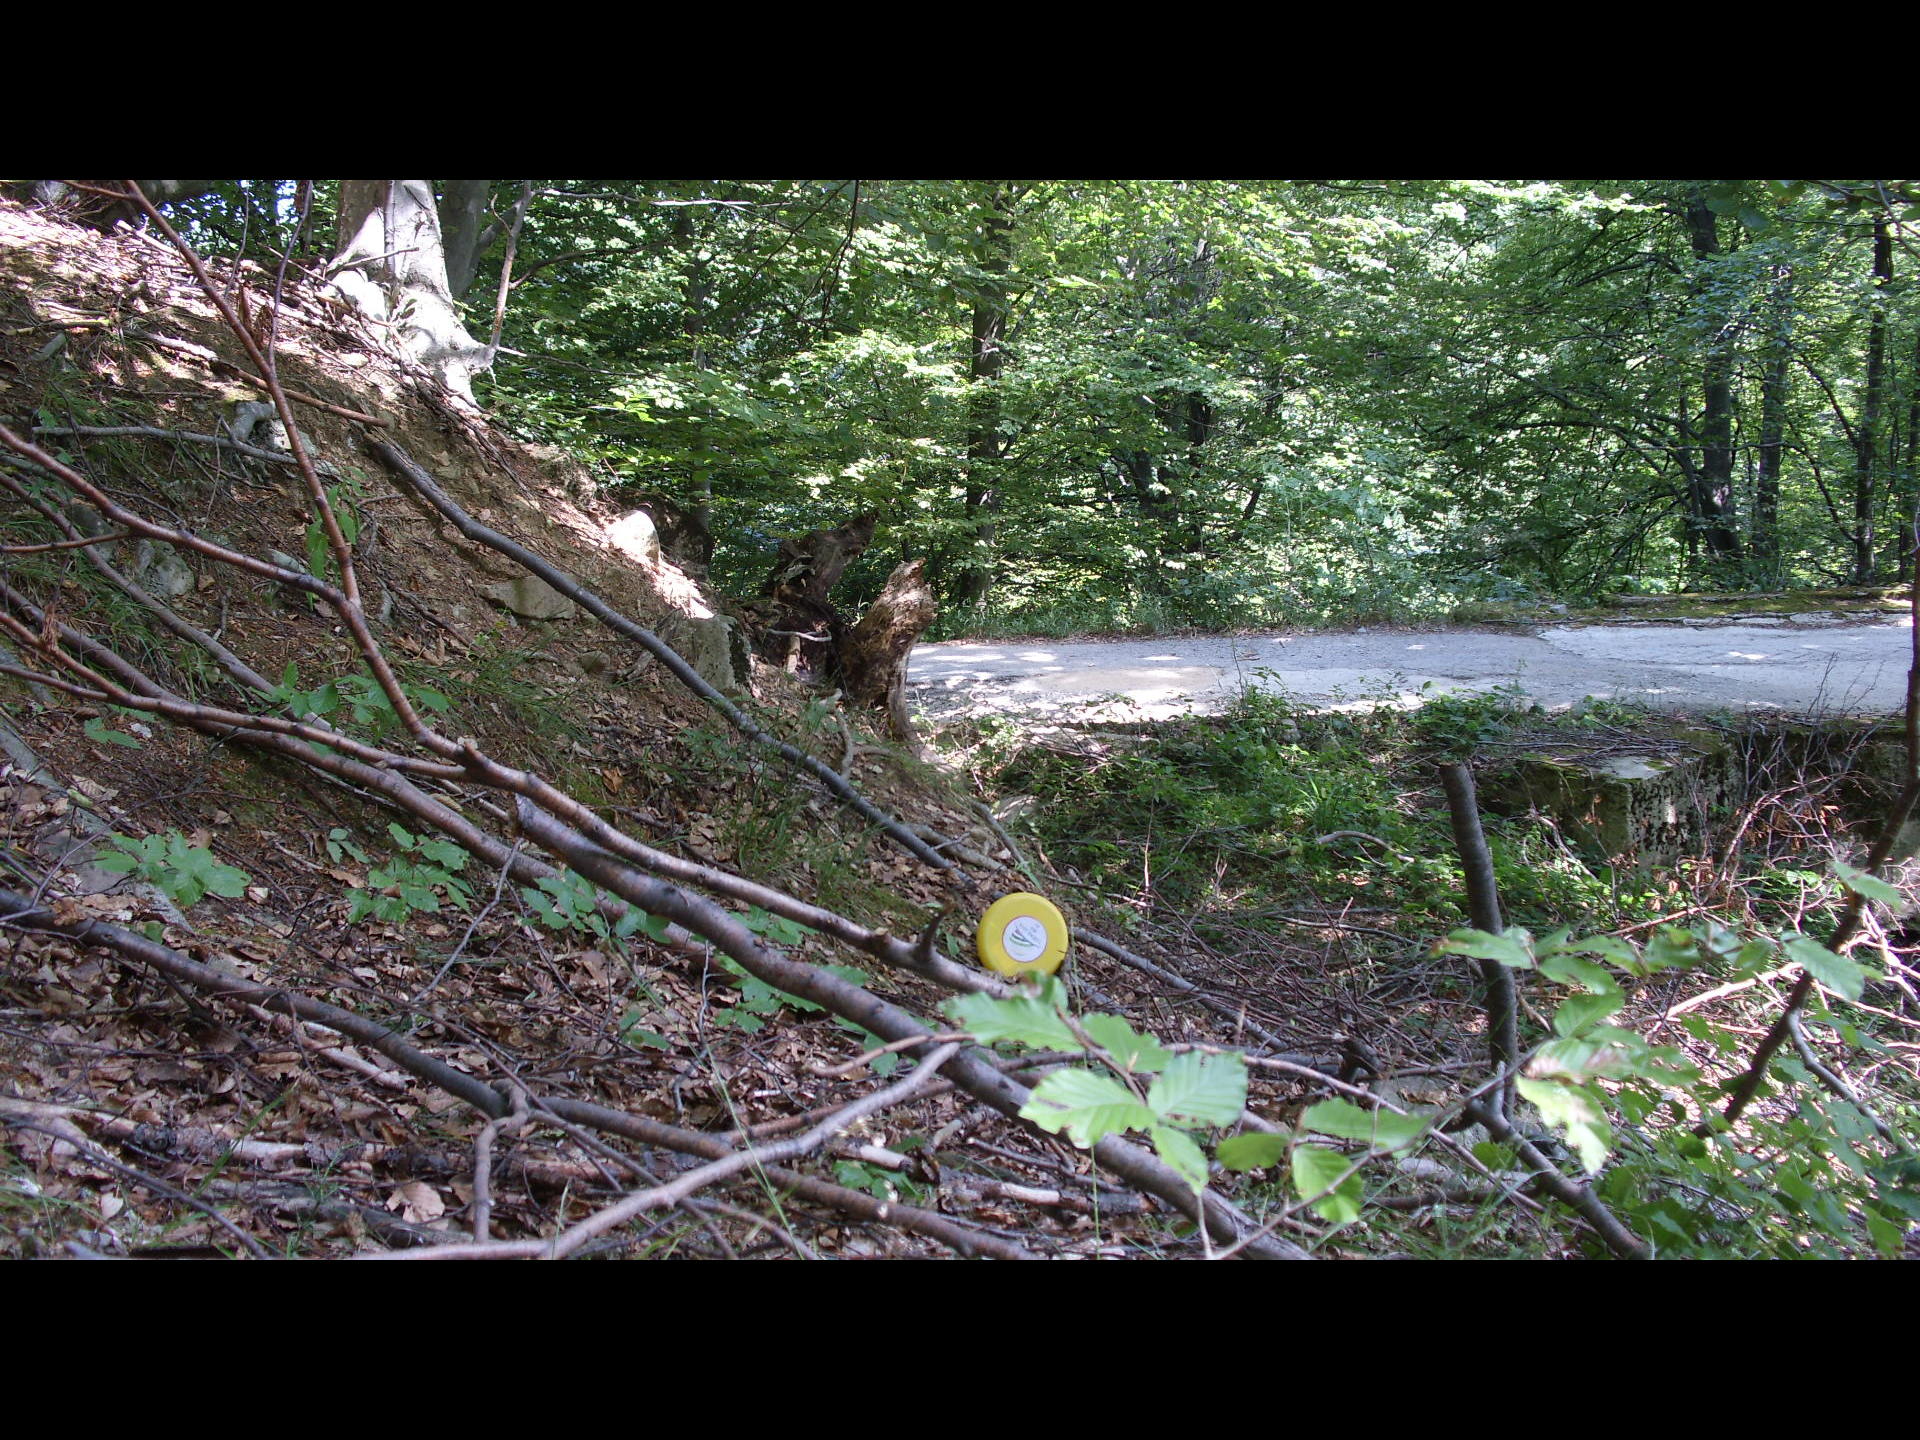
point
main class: Woodland
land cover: Broadleaved woodland
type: beech forest
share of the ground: > 75 %
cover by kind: broadleaved forest trees 90 %, shrubs 5 %, herbaceous plants 5 %
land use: Forestry
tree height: > 5 m
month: August
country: BG
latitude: 43.1520
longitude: 23.2321
